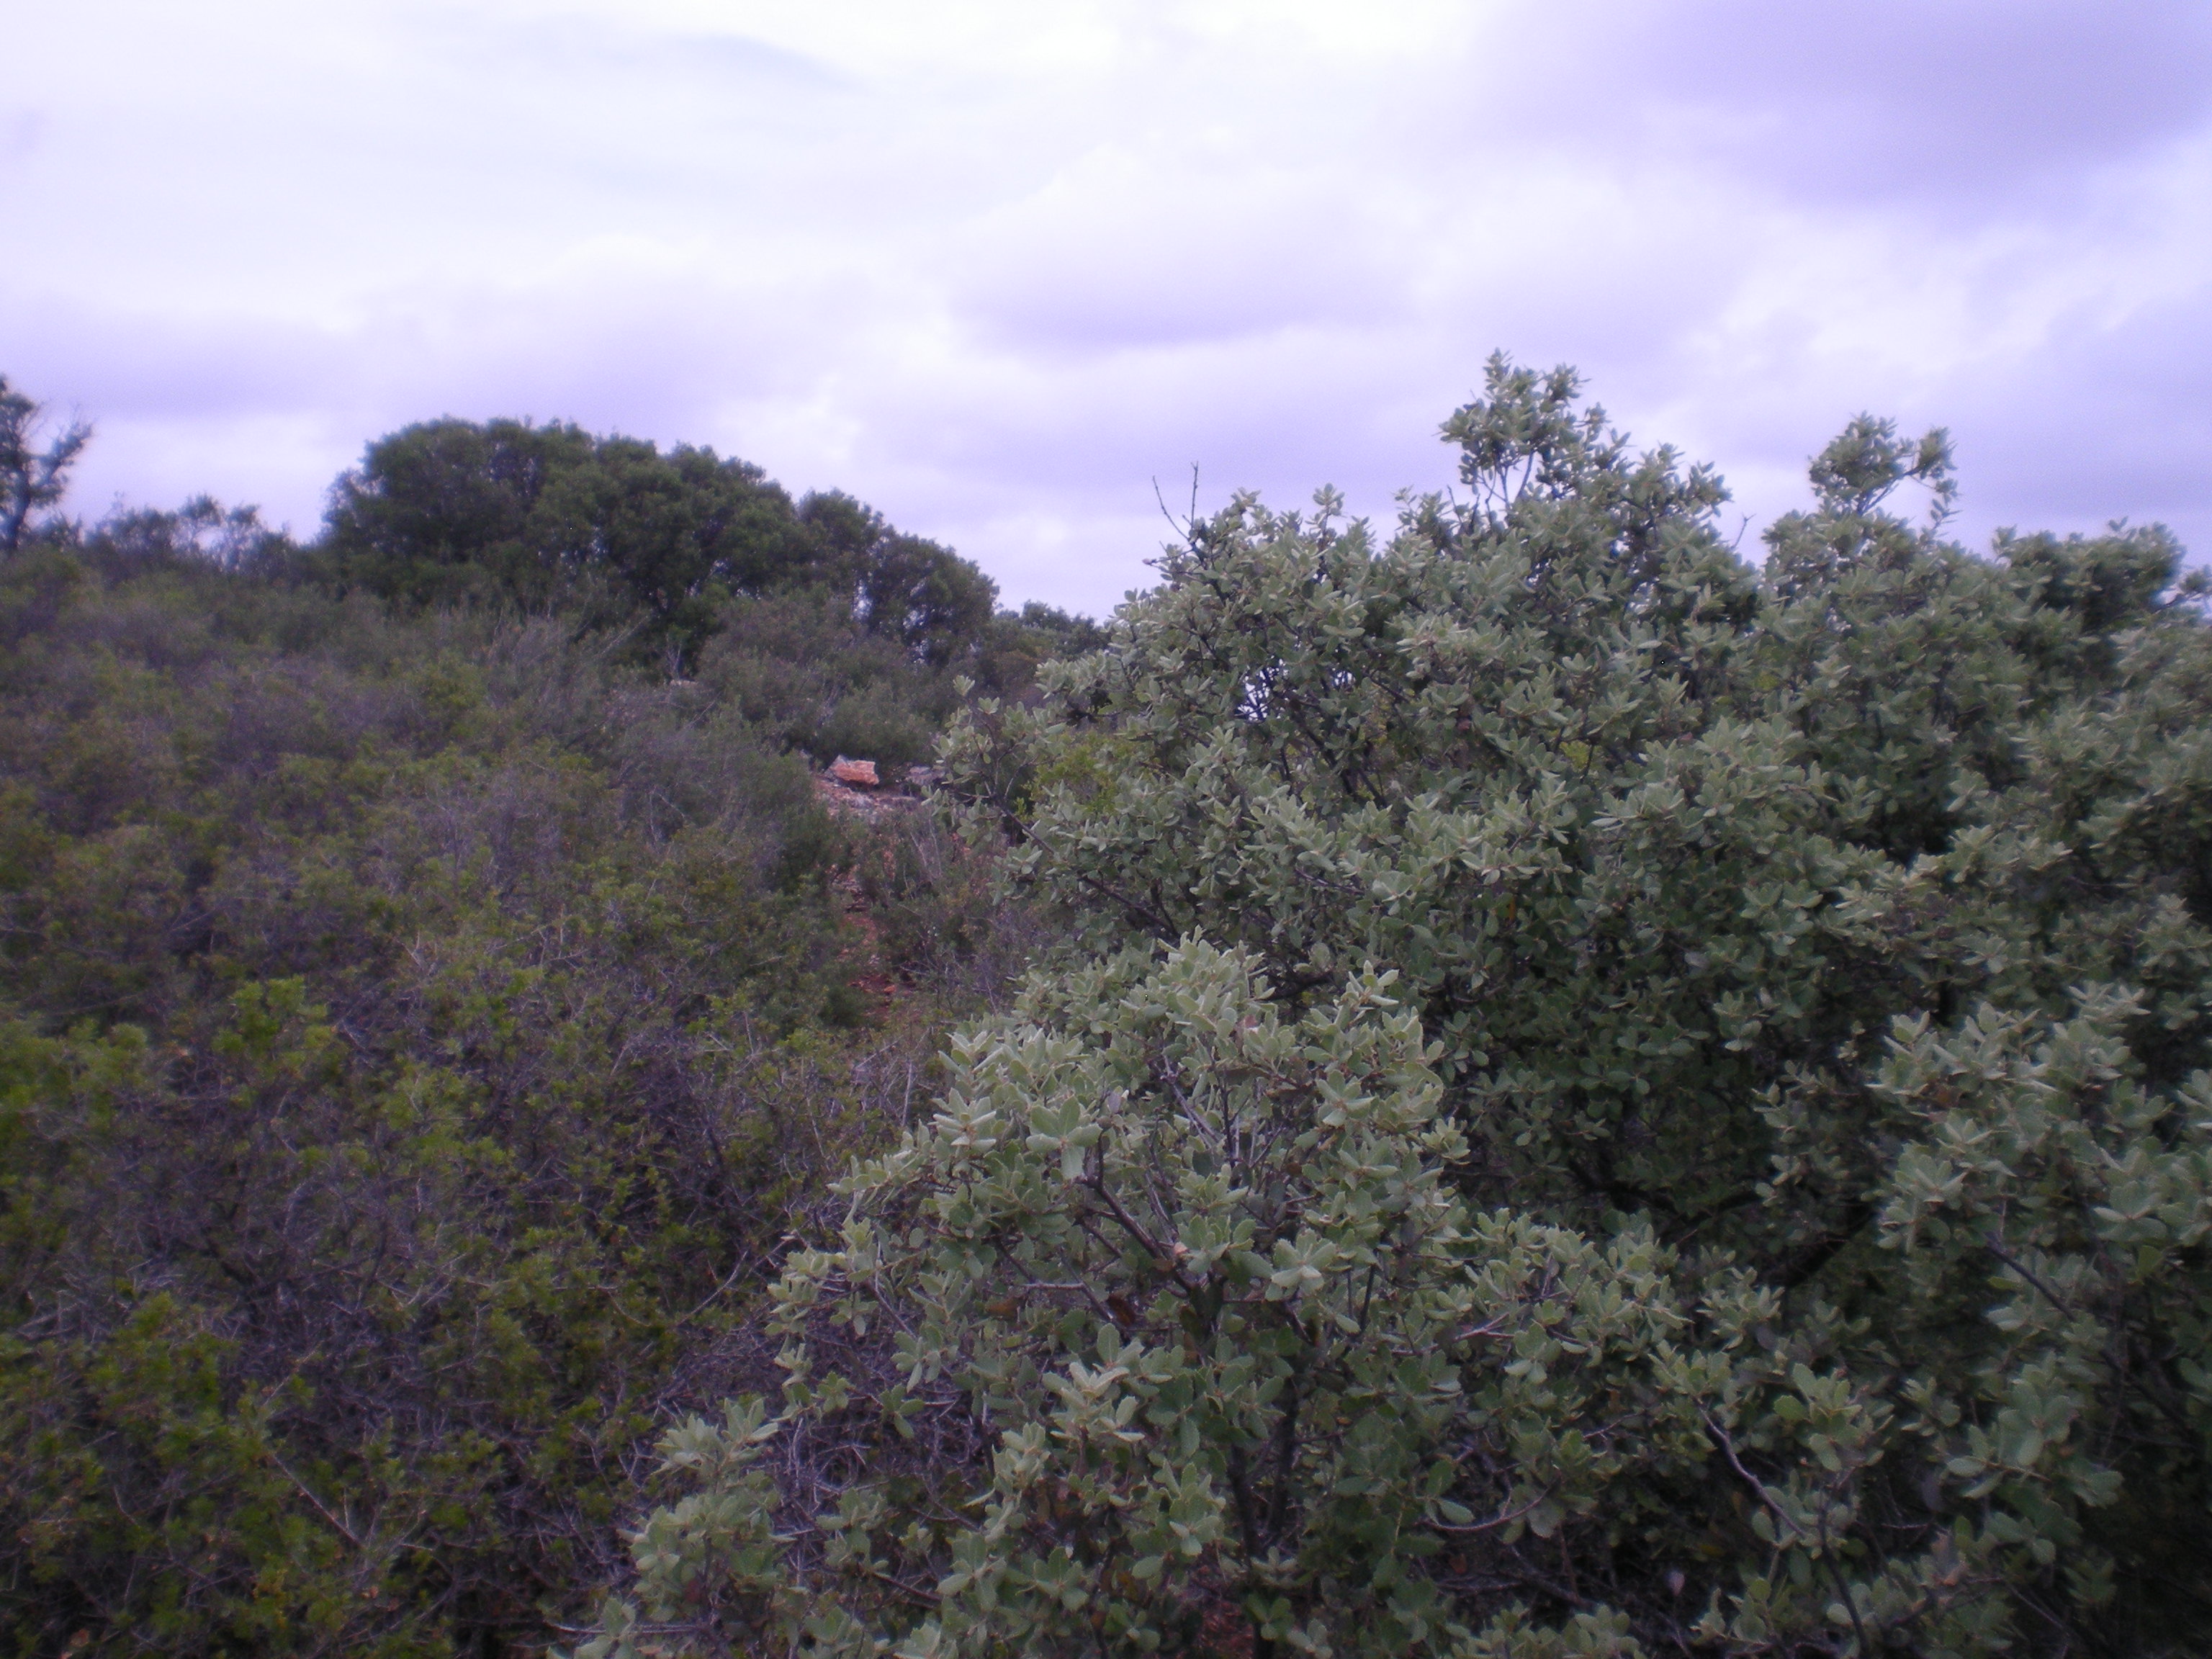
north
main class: Woodland
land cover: Broadleaved woodland
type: broadleaved evergreen forest
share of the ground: 50 - 75 %
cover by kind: broadleaved forest trees 40 %, shrubs 30 %, unconsolidated bare surface 20 %, herbaceous plants 10 %
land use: Other primary production
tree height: < 5 m
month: May
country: ES
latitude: 38.8352
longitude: -2.9678
